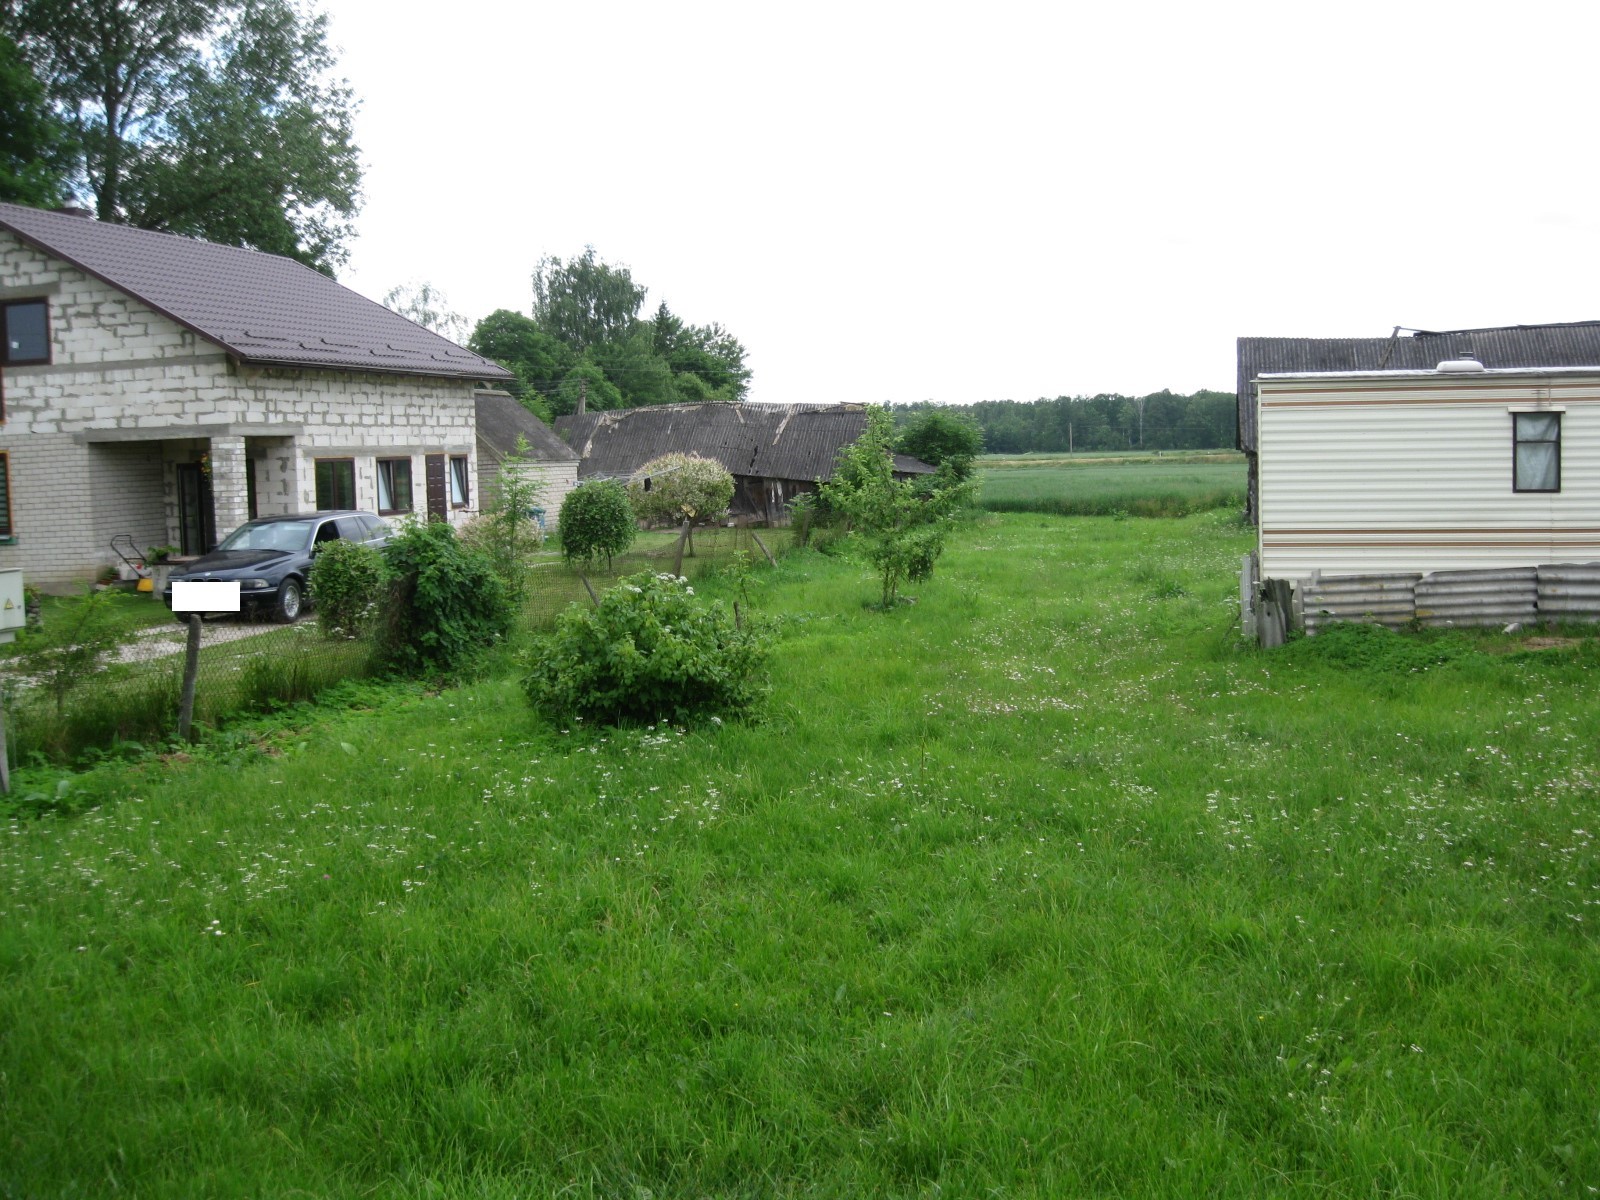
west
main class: Grassland
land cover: Grassland with sparse tree/shrub cover
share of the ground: > 75 %
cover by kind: herbaceous plants 90 %, broadleaved forest trees 5 %, shrubs 5 %
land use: Agriculture (excluding fallow land and kitchen gardens)
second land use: Residential
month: June
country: LT
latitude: 55.3265
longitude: 24.1361
